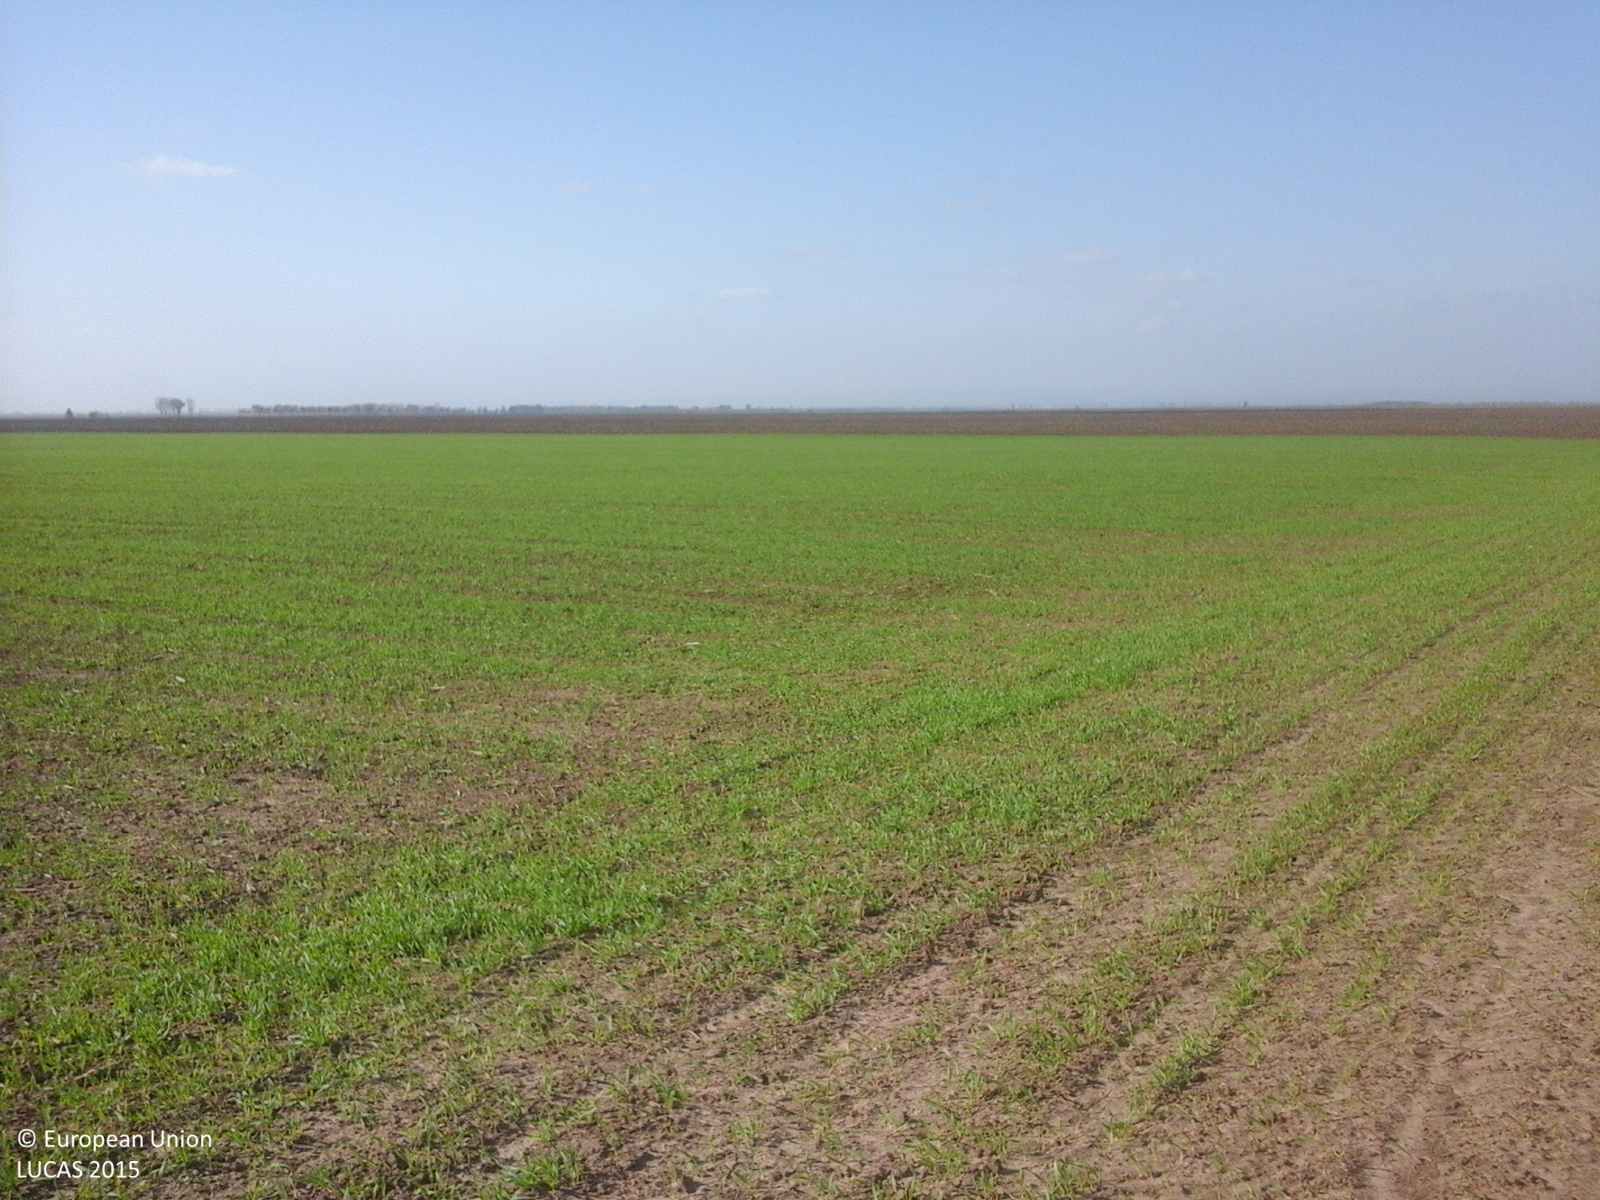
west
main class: Cropland
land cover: Common wheat
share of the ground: 25 - 50 %
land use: Agriculture (excluding fallow land and kitchen gardens)
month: October
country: RO
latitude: 45.3055
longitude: 27.3521
